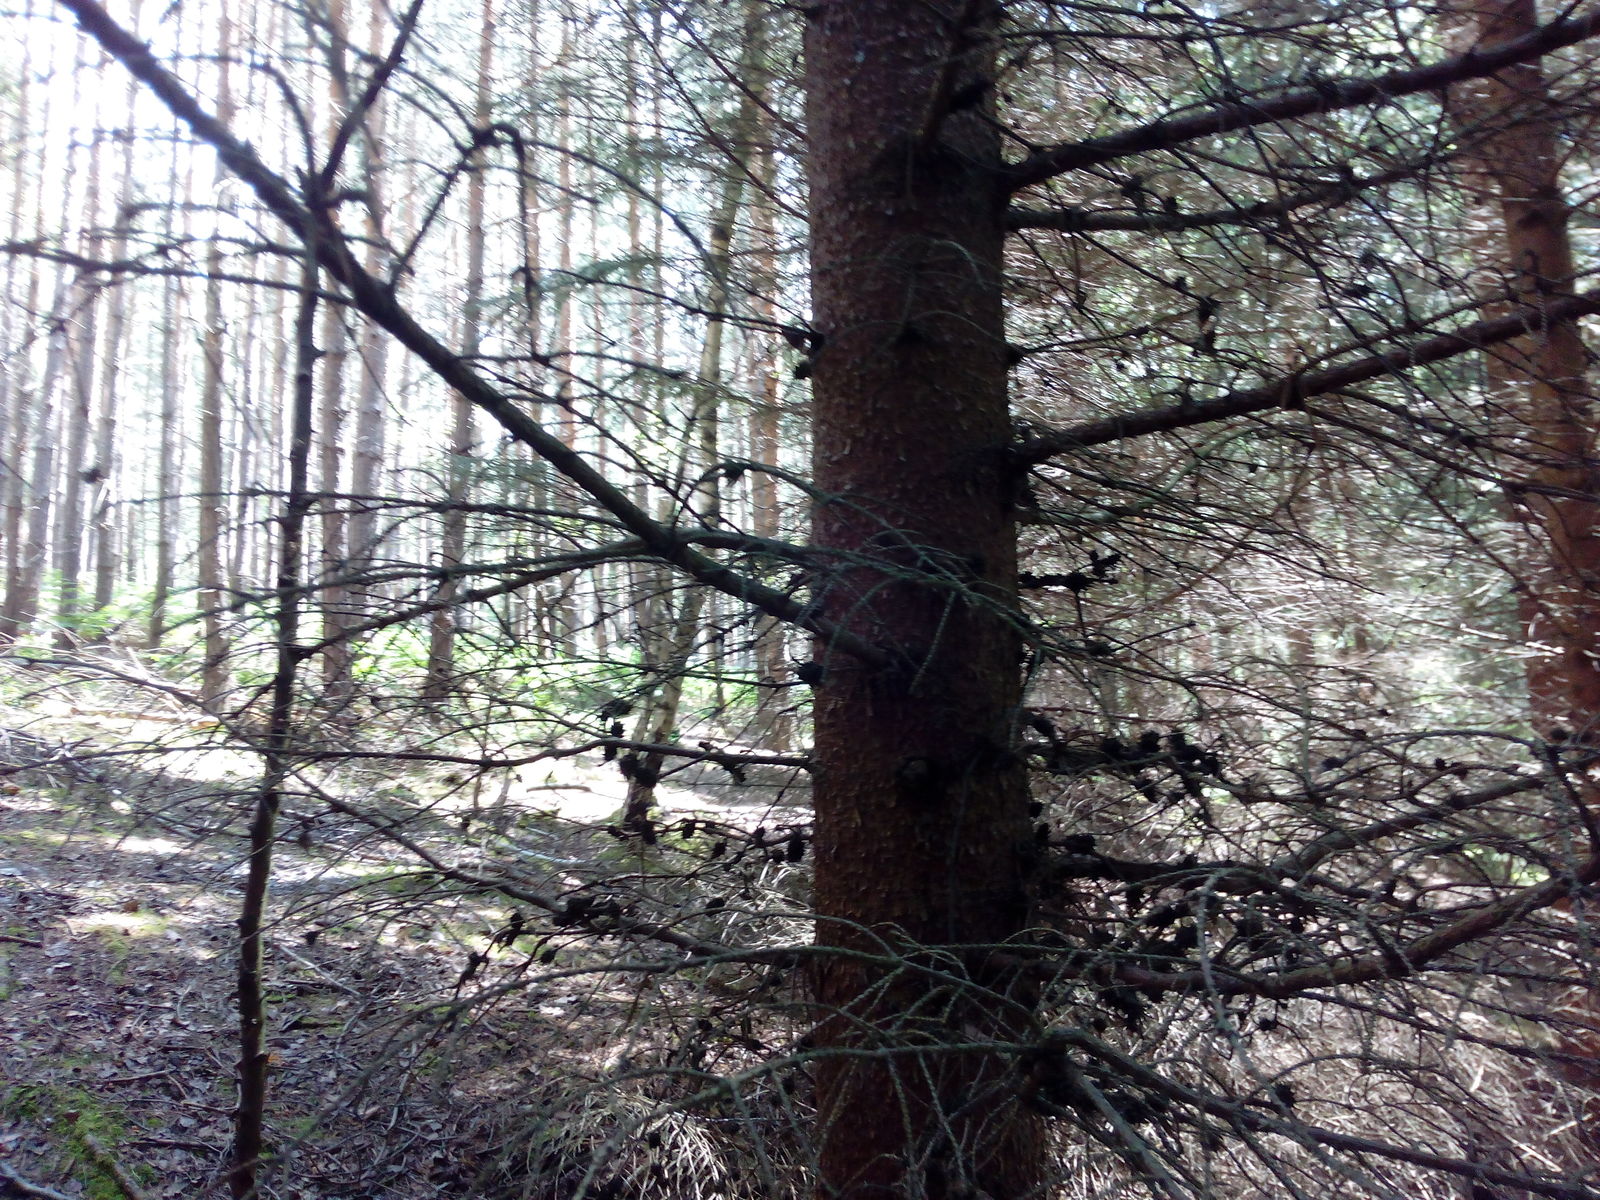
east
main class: Woodland
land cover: Spruce dominated coniferous woodland
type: hemiboreal forest and nemoral coniferous forest and mixed broadleaved-coniferous forest
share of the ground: > 75 %
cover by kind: coniferous forest trees 100 %
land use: Forestry
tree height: > 5 m
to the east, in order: Spruce dominated coniferous woodland; Pine dominated coniferous woodland; Tracks; Pine dominated coniferous woodland; Spruce dominated coniferous woodland; Pine dominated coniferous woodland
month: June
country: DE
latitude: 50.7018
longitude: 10.9484
